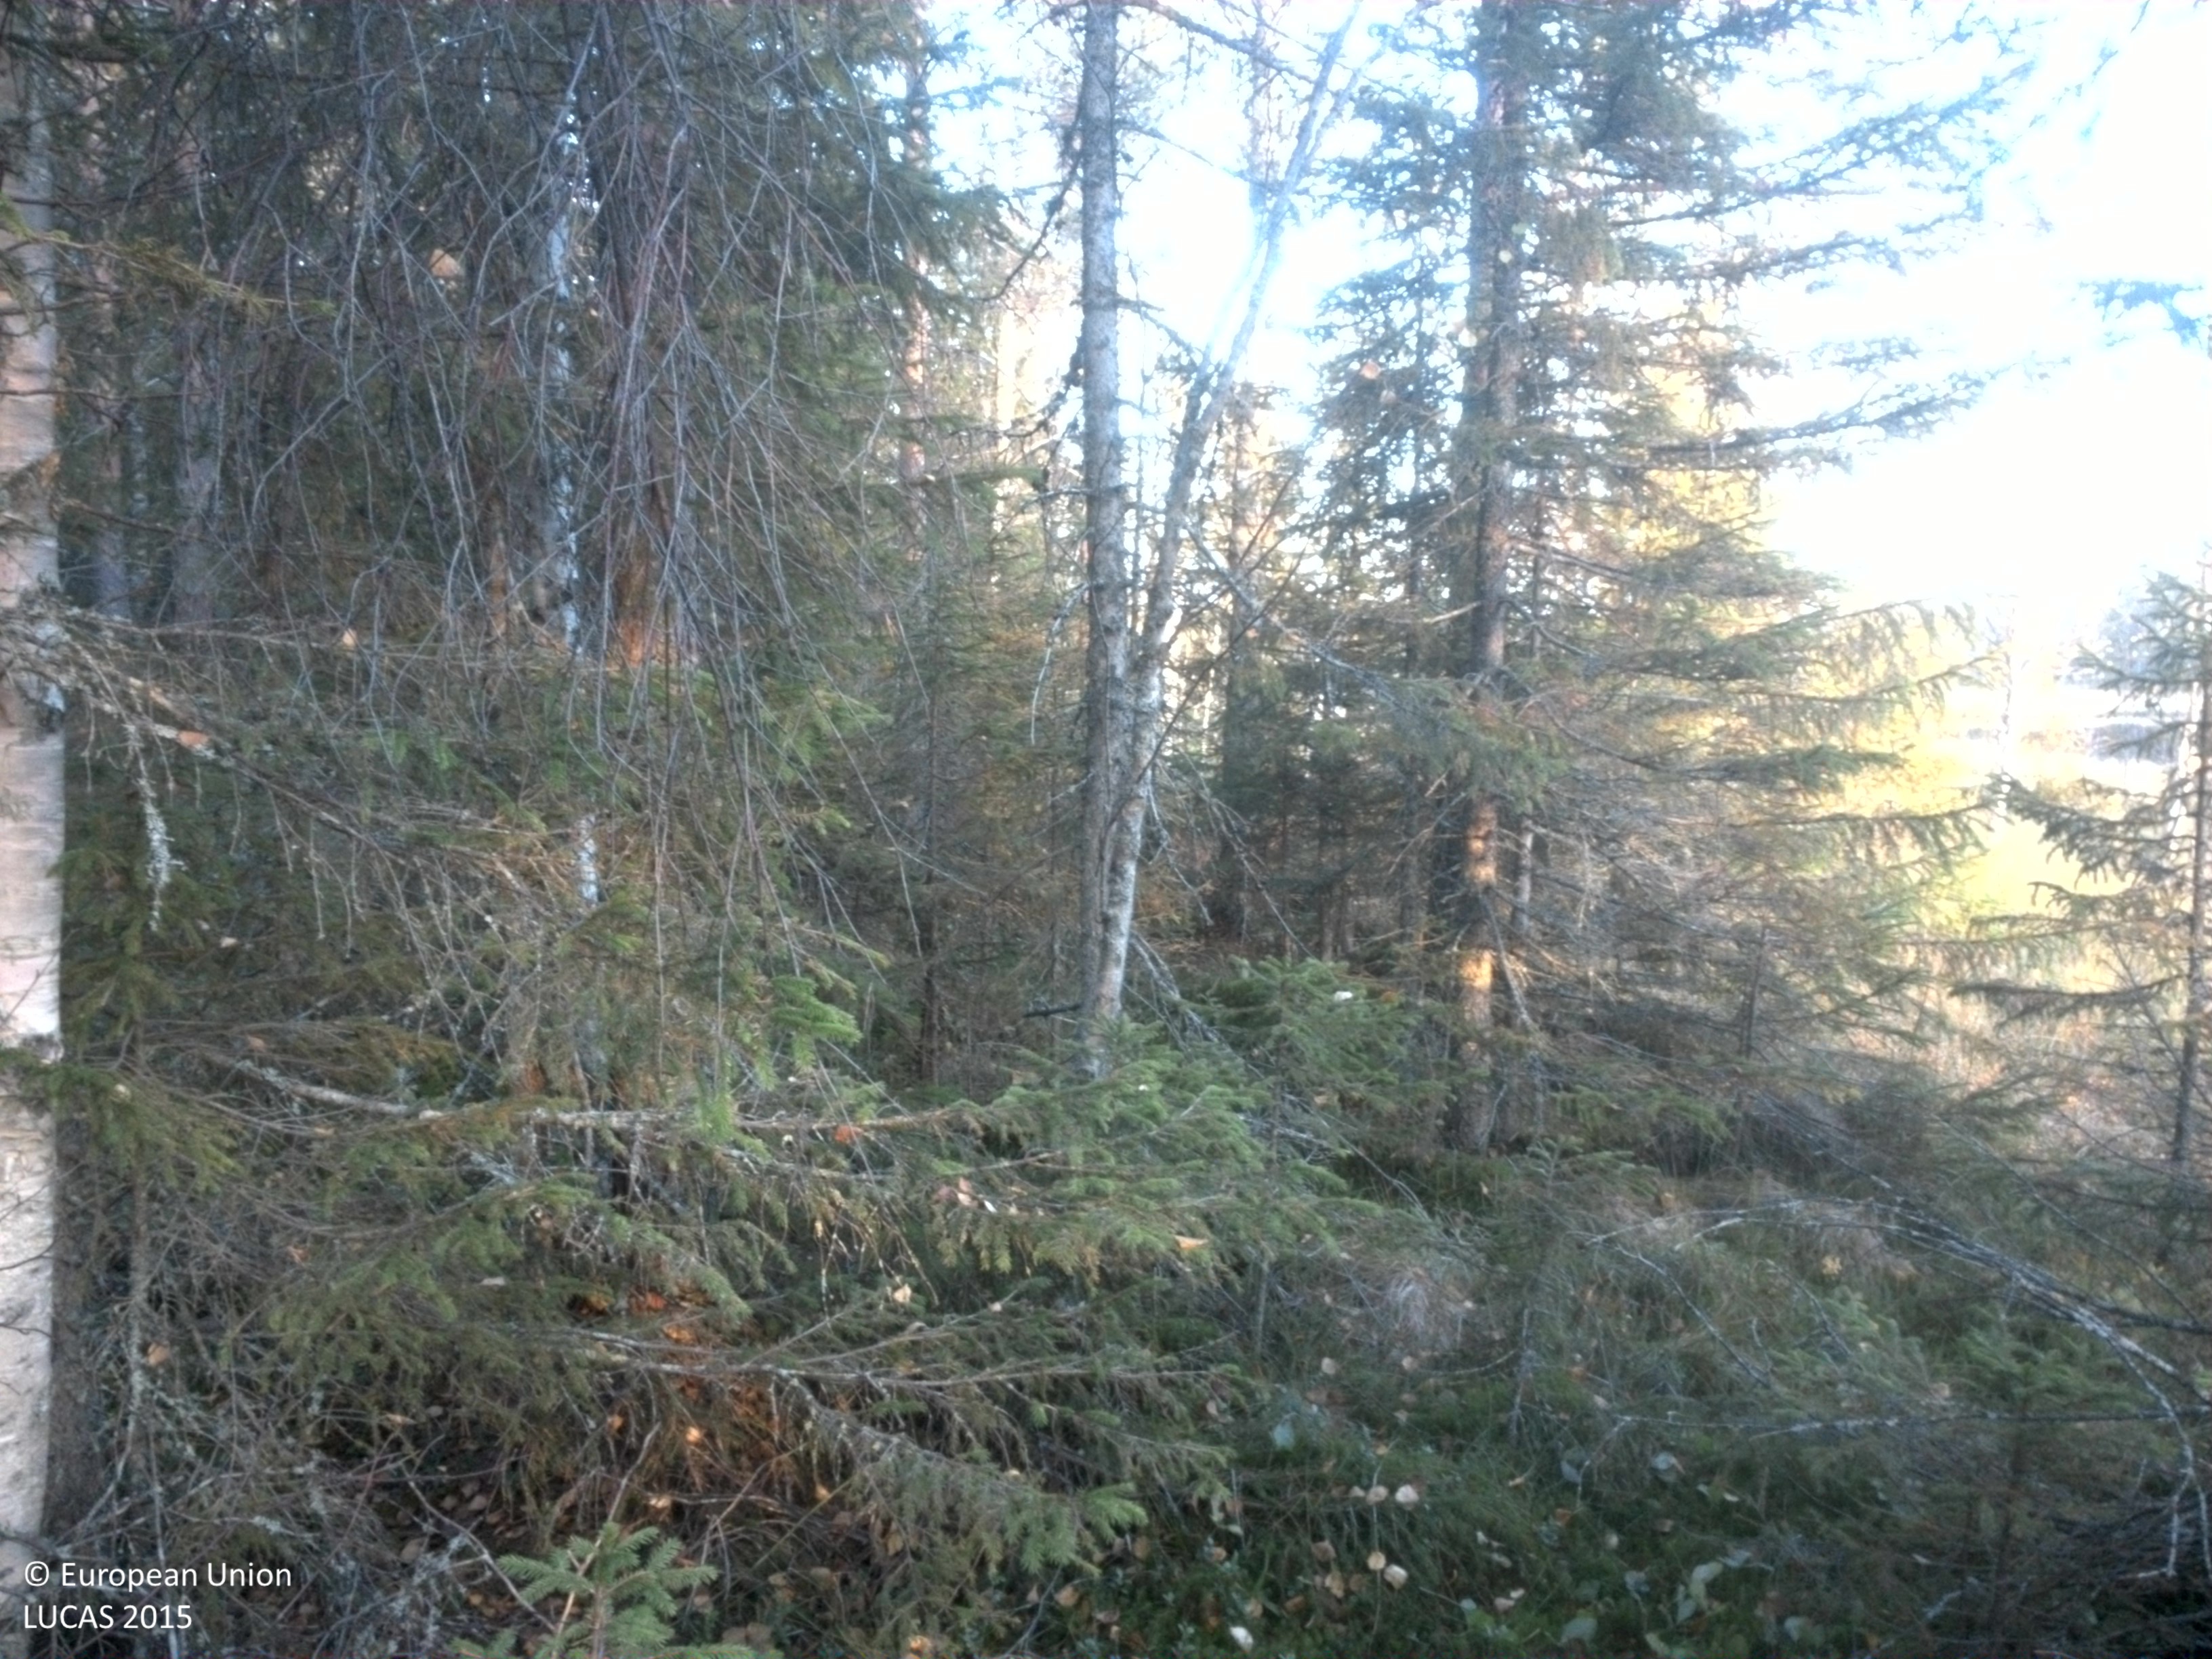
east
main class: Woodland
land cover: Other mixed woodland
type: boreal forest
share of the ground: 50 - 75 %
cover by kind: coniferous forest trees 45 %, broadleaved forest trees 20 %, shrubs 20 %, lichens and mosses 10 %, herbaceous plants 5 %
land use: Forestry
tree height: > 5 m
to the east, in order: Other mixed woodland; Tracks; Other mixed woodland; Spruce dominated mixed woodland; Pine dominated mixed woodland; Broadleaved woodland
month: September
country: SE
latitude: 64.1681
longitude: 20.0772
